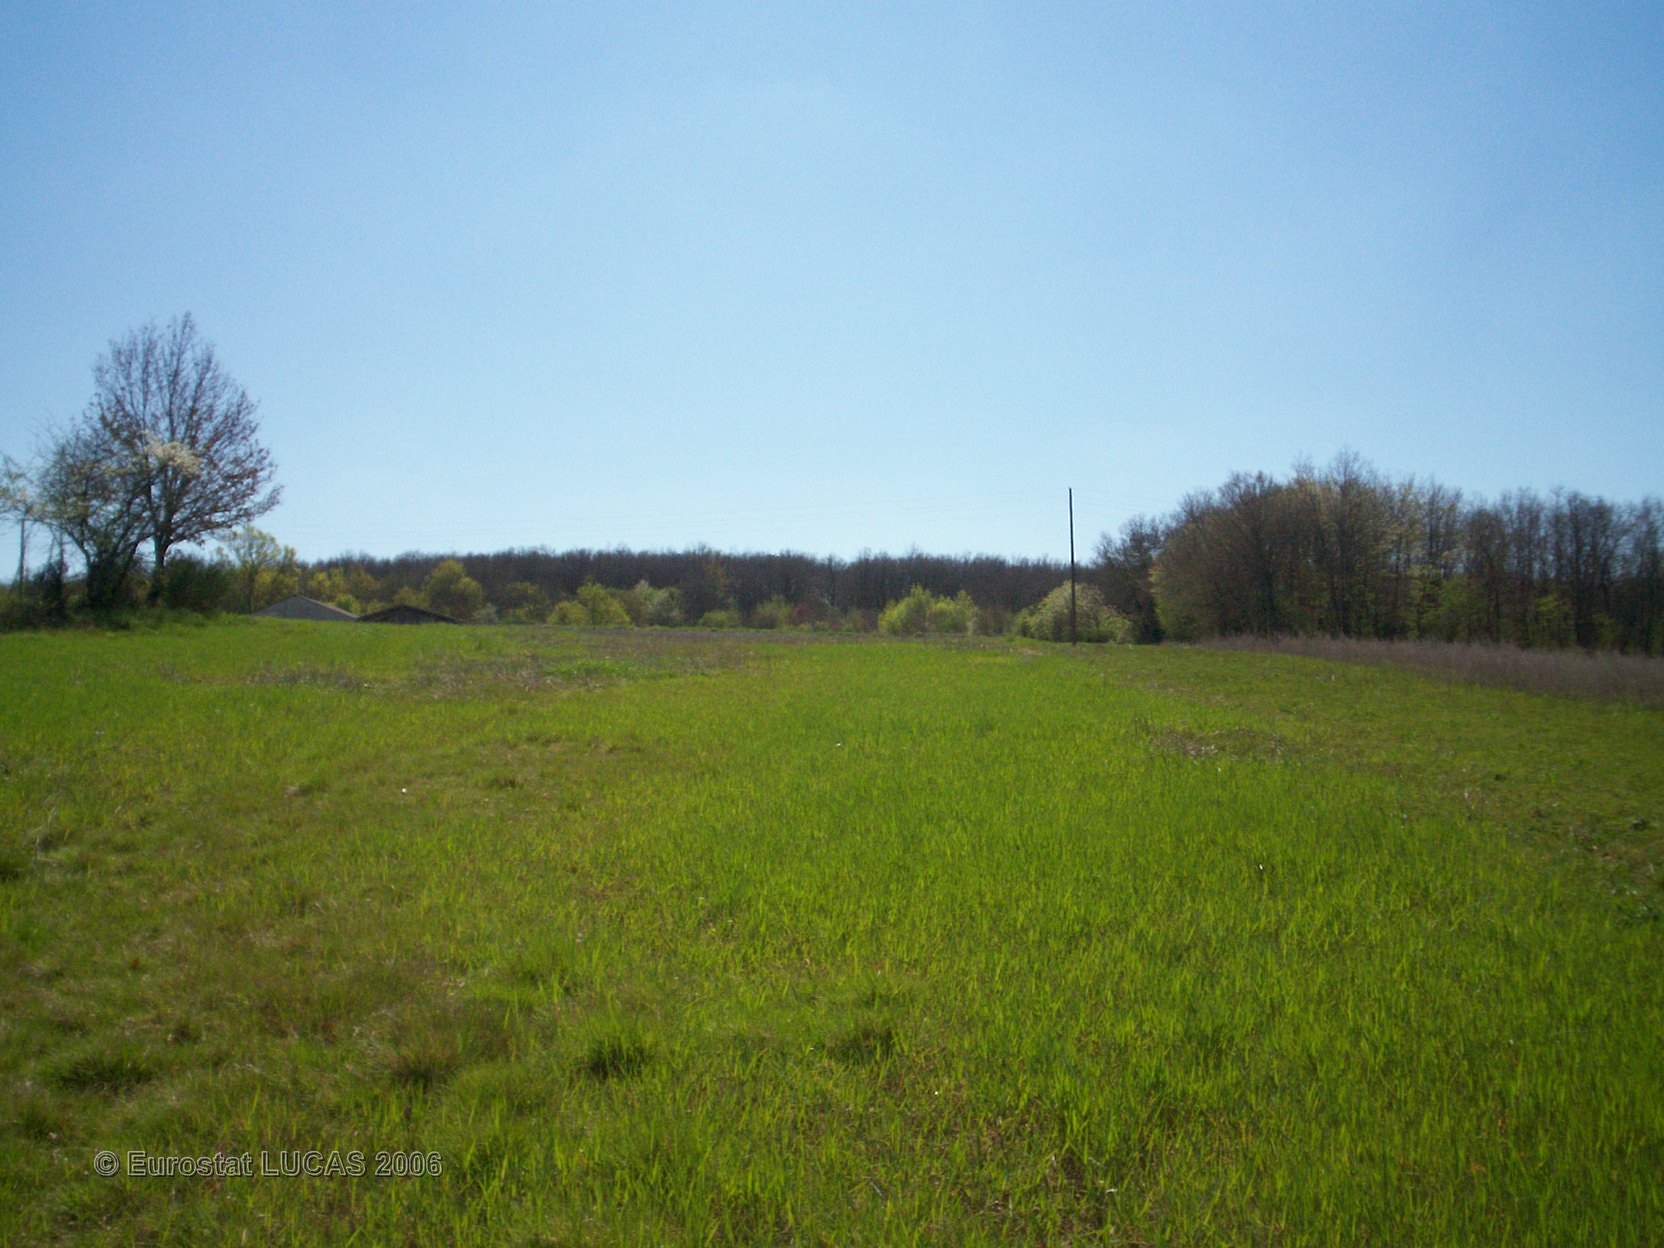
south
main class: Grassland
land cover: Grassland without tree/shrub cover
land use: Agriculture (excluding fallow land and kitchen gardens)
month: April
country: FR
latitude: 43.8618
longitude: 0.9282
